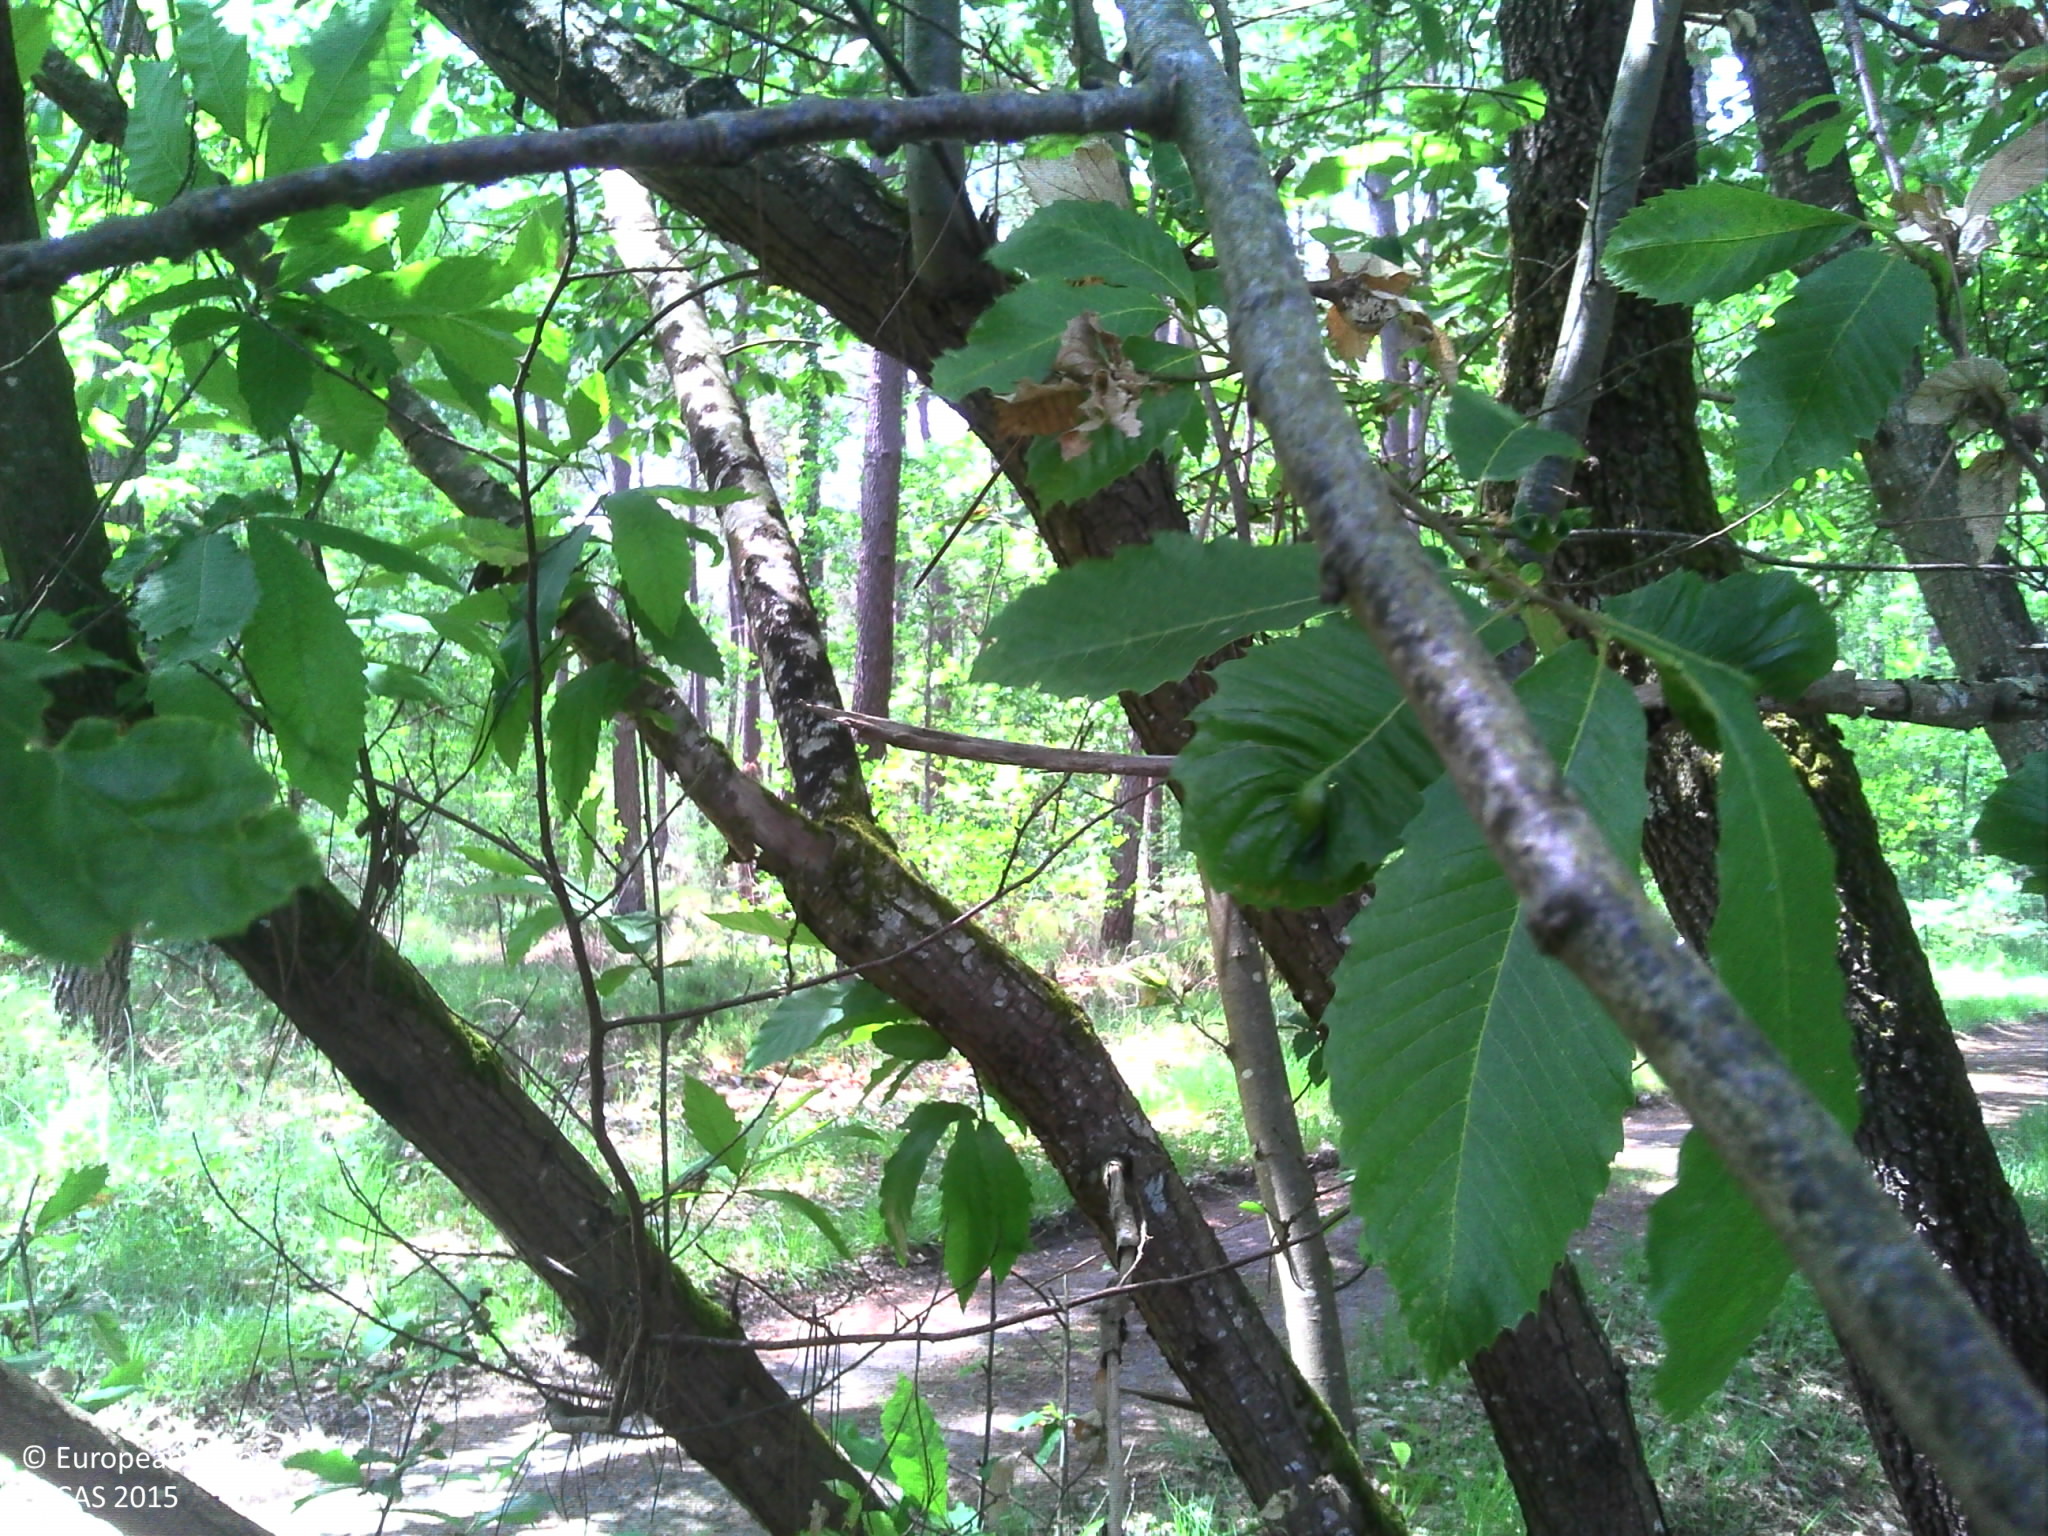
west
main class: Woodland
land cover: Pine dominated coniferous woodland
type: hemiboreal forest and nemoral coniferous forest and mixed broadleaved-coniferous forest
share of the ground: > 75 %
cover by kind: coniferous forest trees 75 %, shrubs 10 %, herbaceous plants 10 %, broadleaved forest trees 5 %
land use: Forestry
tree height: > 5 m
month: June
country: FR
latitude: 47.8063
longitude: 0.0252
